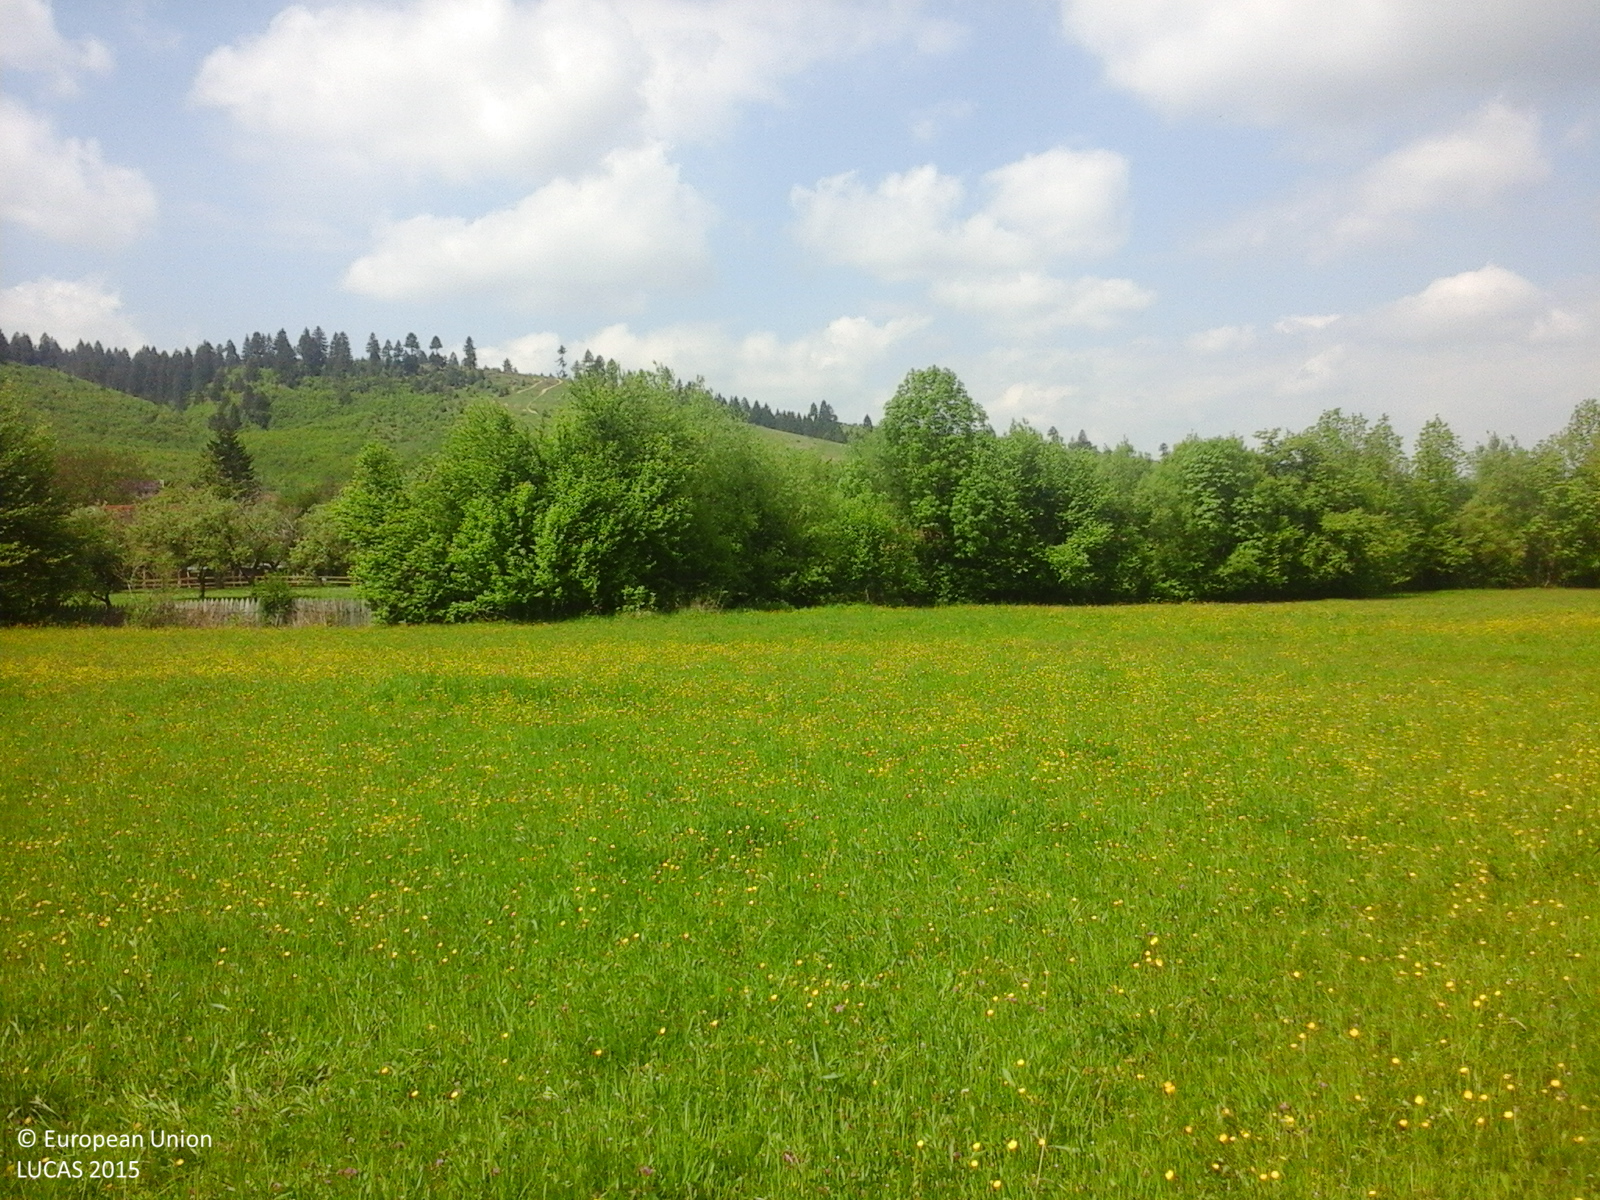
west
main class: Grassland
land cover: Grassland without tree/shrub cover
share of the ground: > 75 %
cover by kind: herbaceous plants 100 %
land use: Agriculture (excluding fallow land and kitchen gardens)
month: May
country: RO
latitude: 45.9761
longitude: 26.2702
